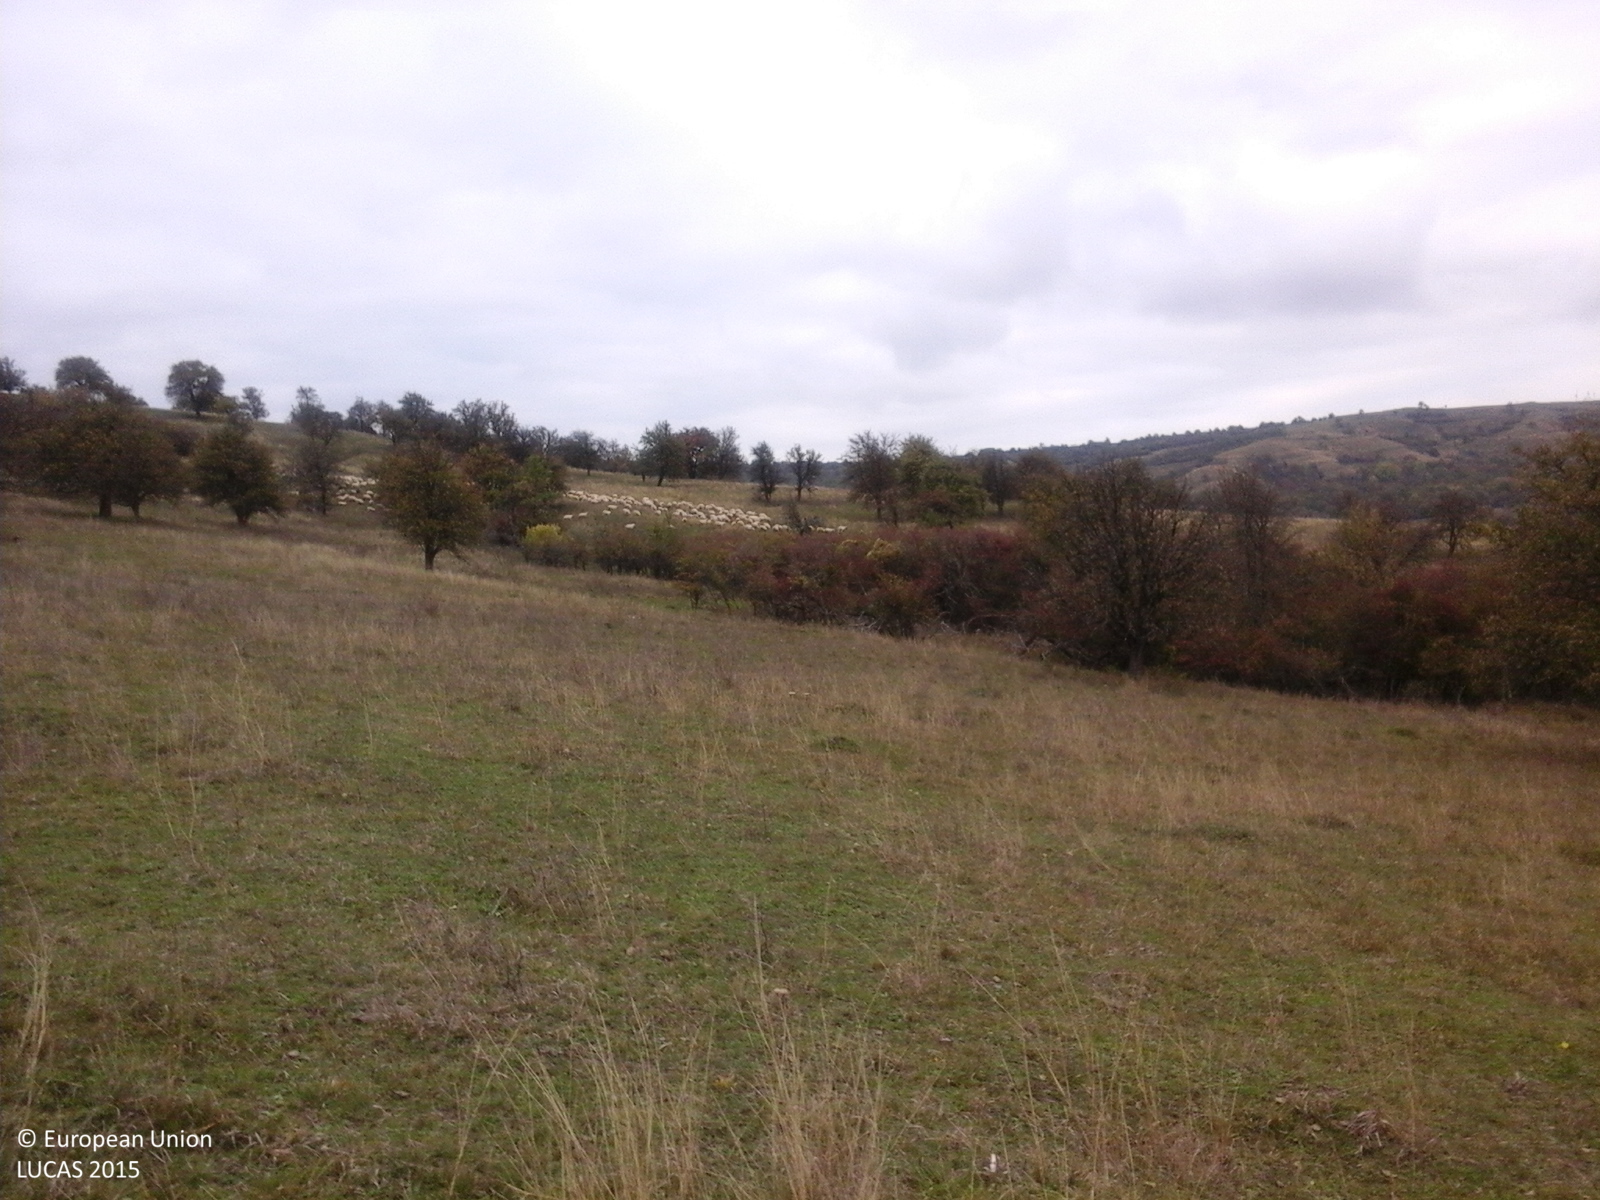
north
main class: Grassland
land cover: Grassland with sparse tree/shrub cover
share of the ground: > 75 %
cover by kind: herbaceous plants 95 %, broadleaved forest trees 5 %
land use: Agriculture (excluding fallow land and kitchen gardens)
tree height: > 5 m
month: October
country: RO
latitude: 45.9501
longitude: 24.8355
